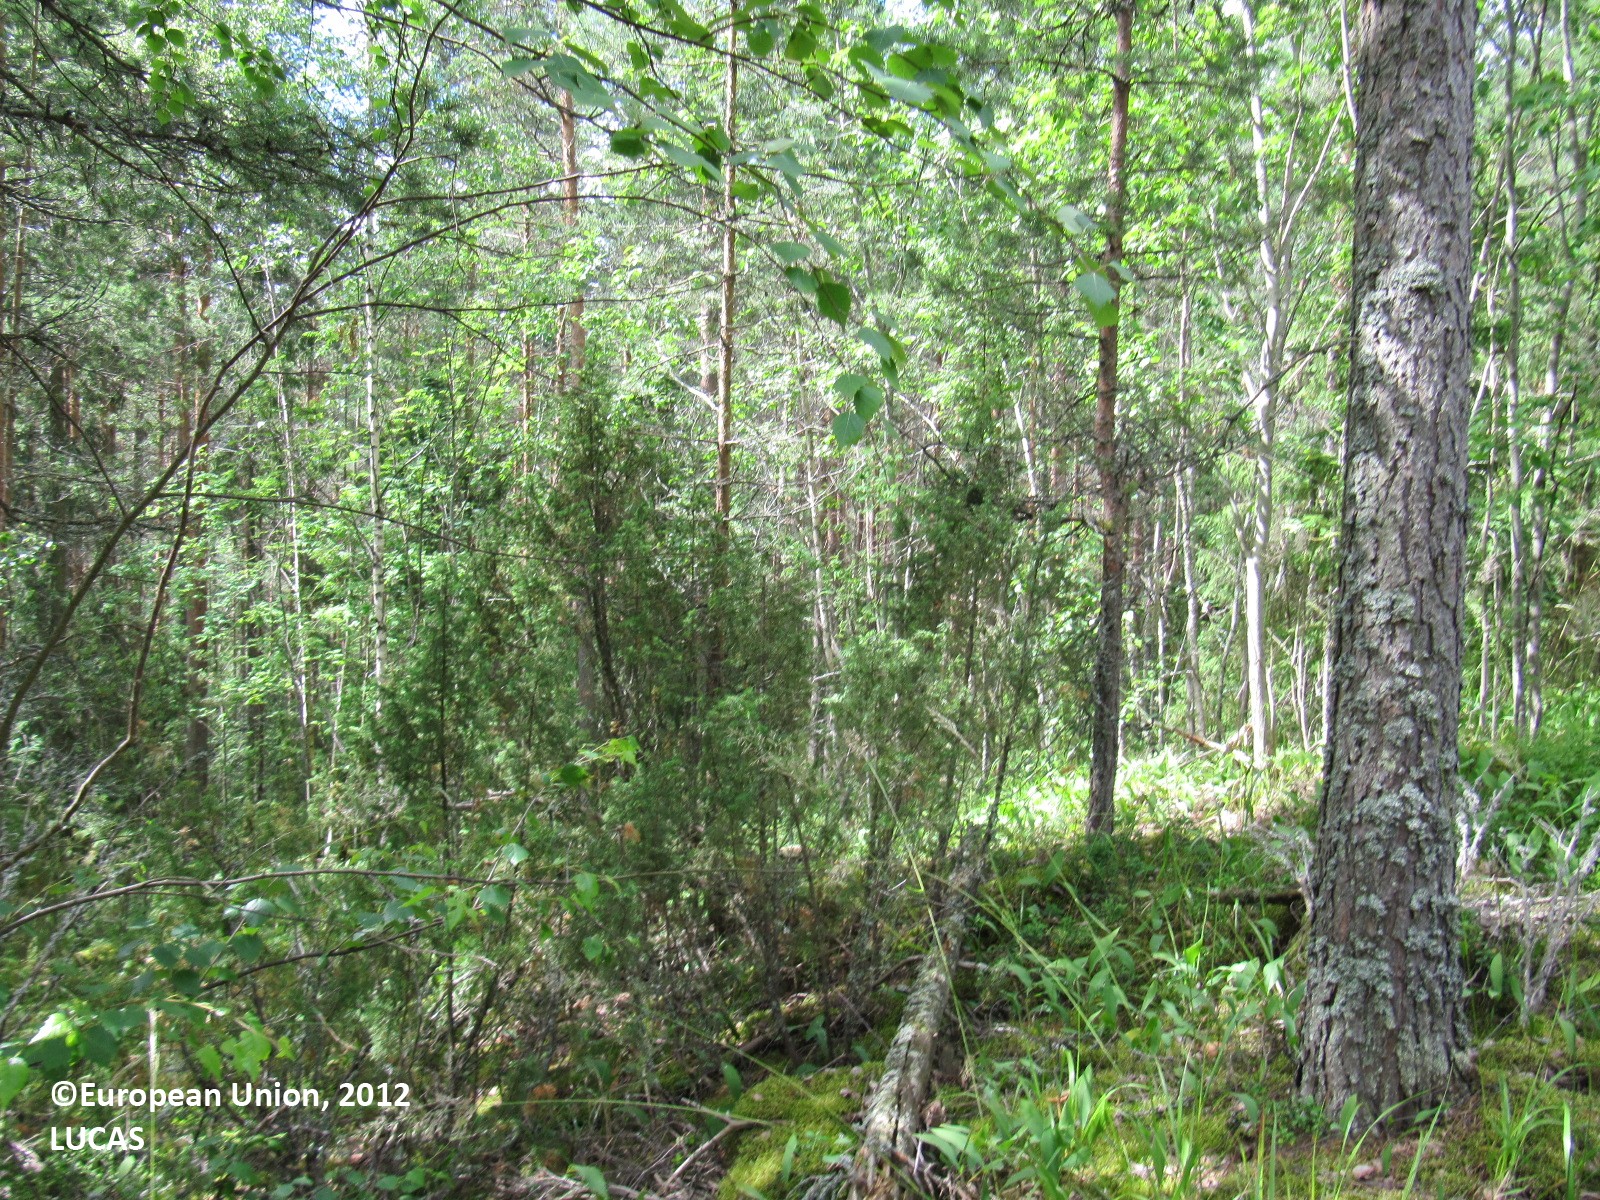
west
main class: Woodland
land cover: Pine dominated mixed woodland
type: boreal forest
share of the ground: 50 - 75 %
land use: Forestry
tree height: > 5 m
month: July
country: FI
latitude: 60.7533
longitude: 24.6209
